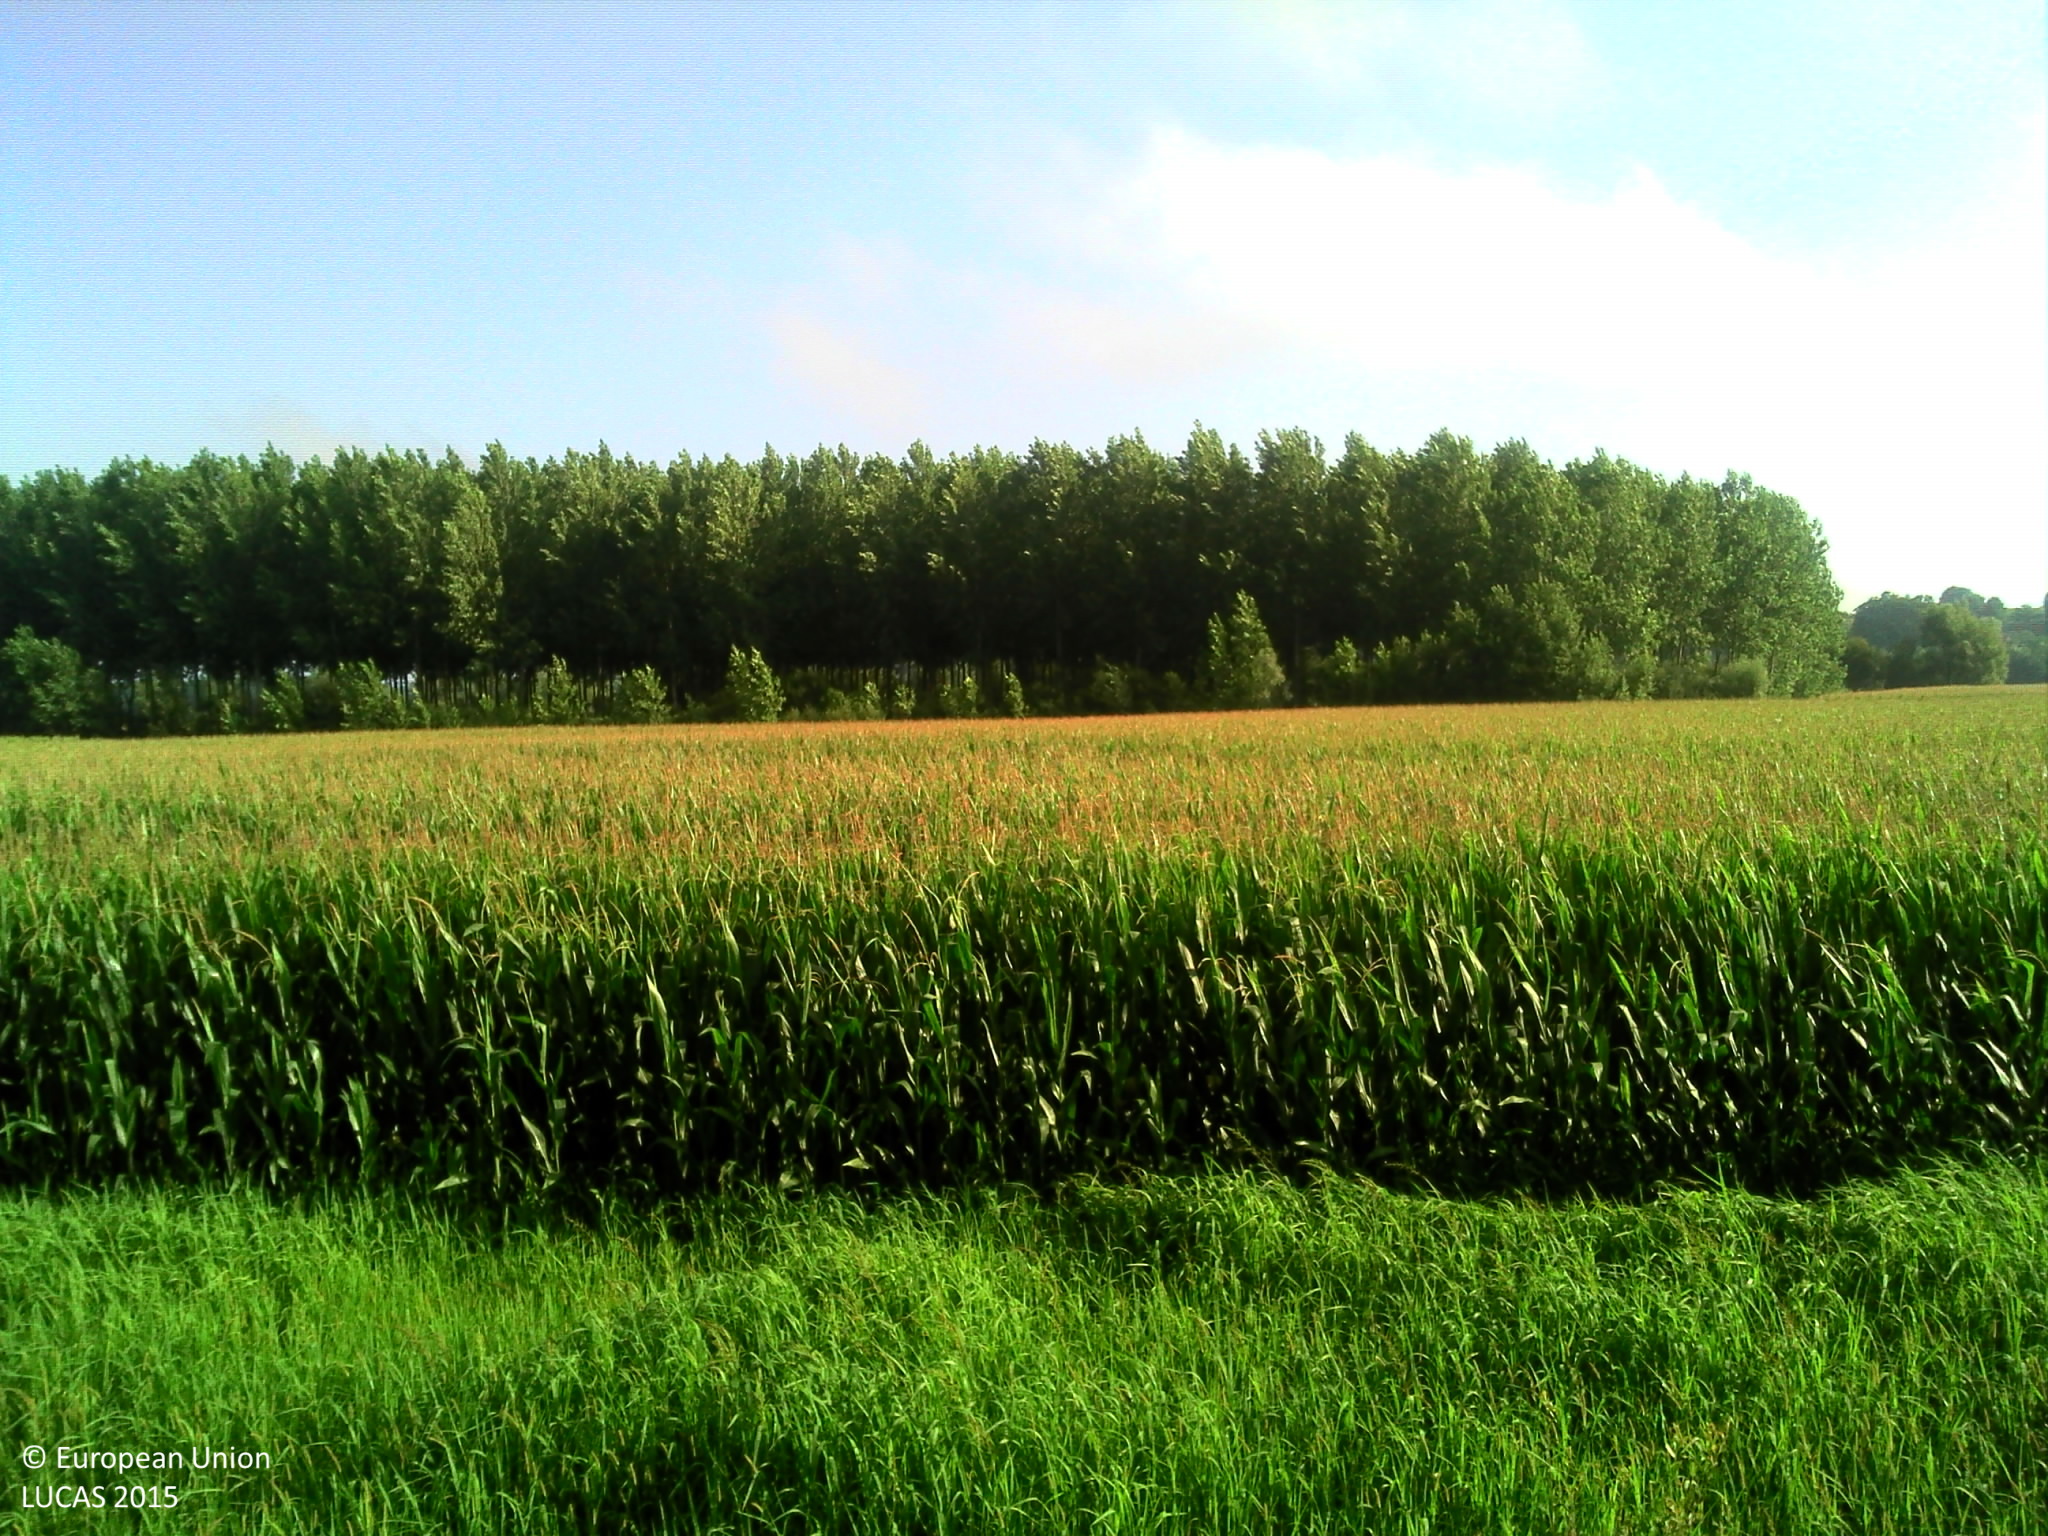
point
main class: Cropland
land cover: Maize
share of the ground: > 75 %
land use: Agriculture (excluding fallow land and kitchen gardens)
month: August
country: FR
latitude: 43.4922
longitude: -1.1568
